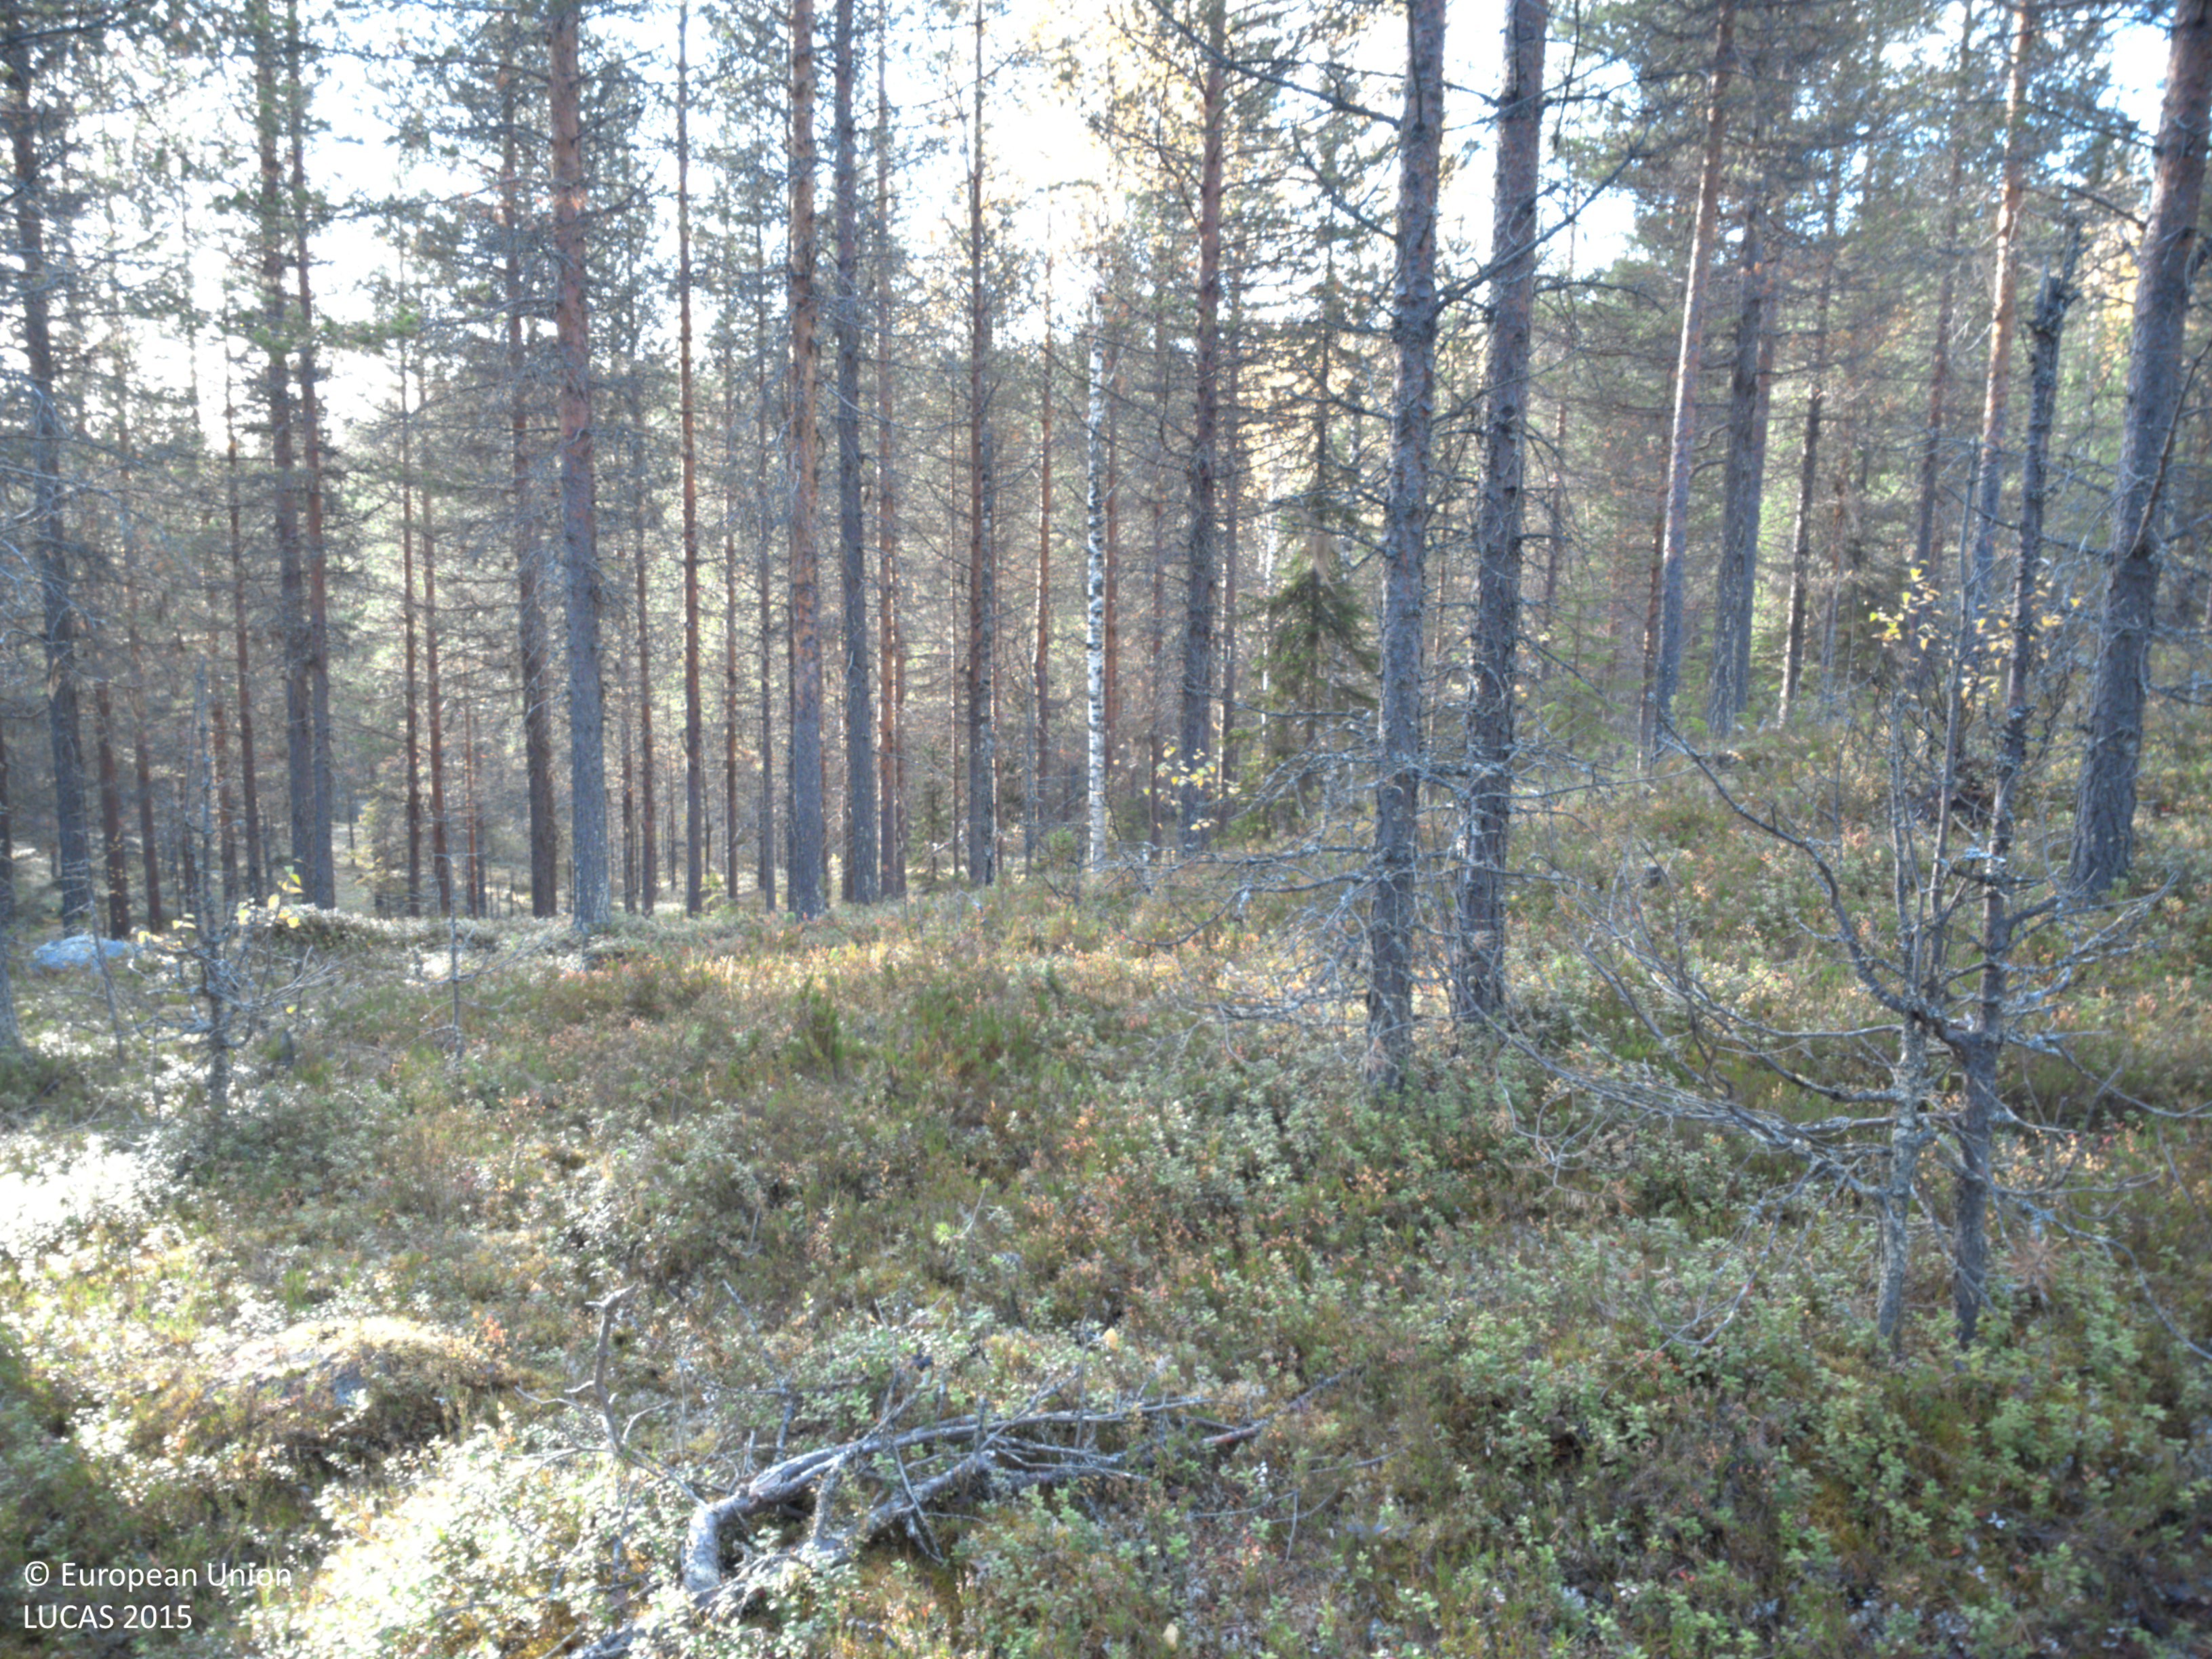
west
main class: Woodland
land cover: Pine dominated coniferous woodland
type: boreal forest
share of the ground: > 75 %
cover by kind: coniferous forest trees 70 %, shrubs 25 %, lichens and mosses 5 %
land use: Forestry
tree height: > 5 m
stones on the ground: < 10 %
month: September
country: SE
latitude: 64.9343
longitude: 18.4902
